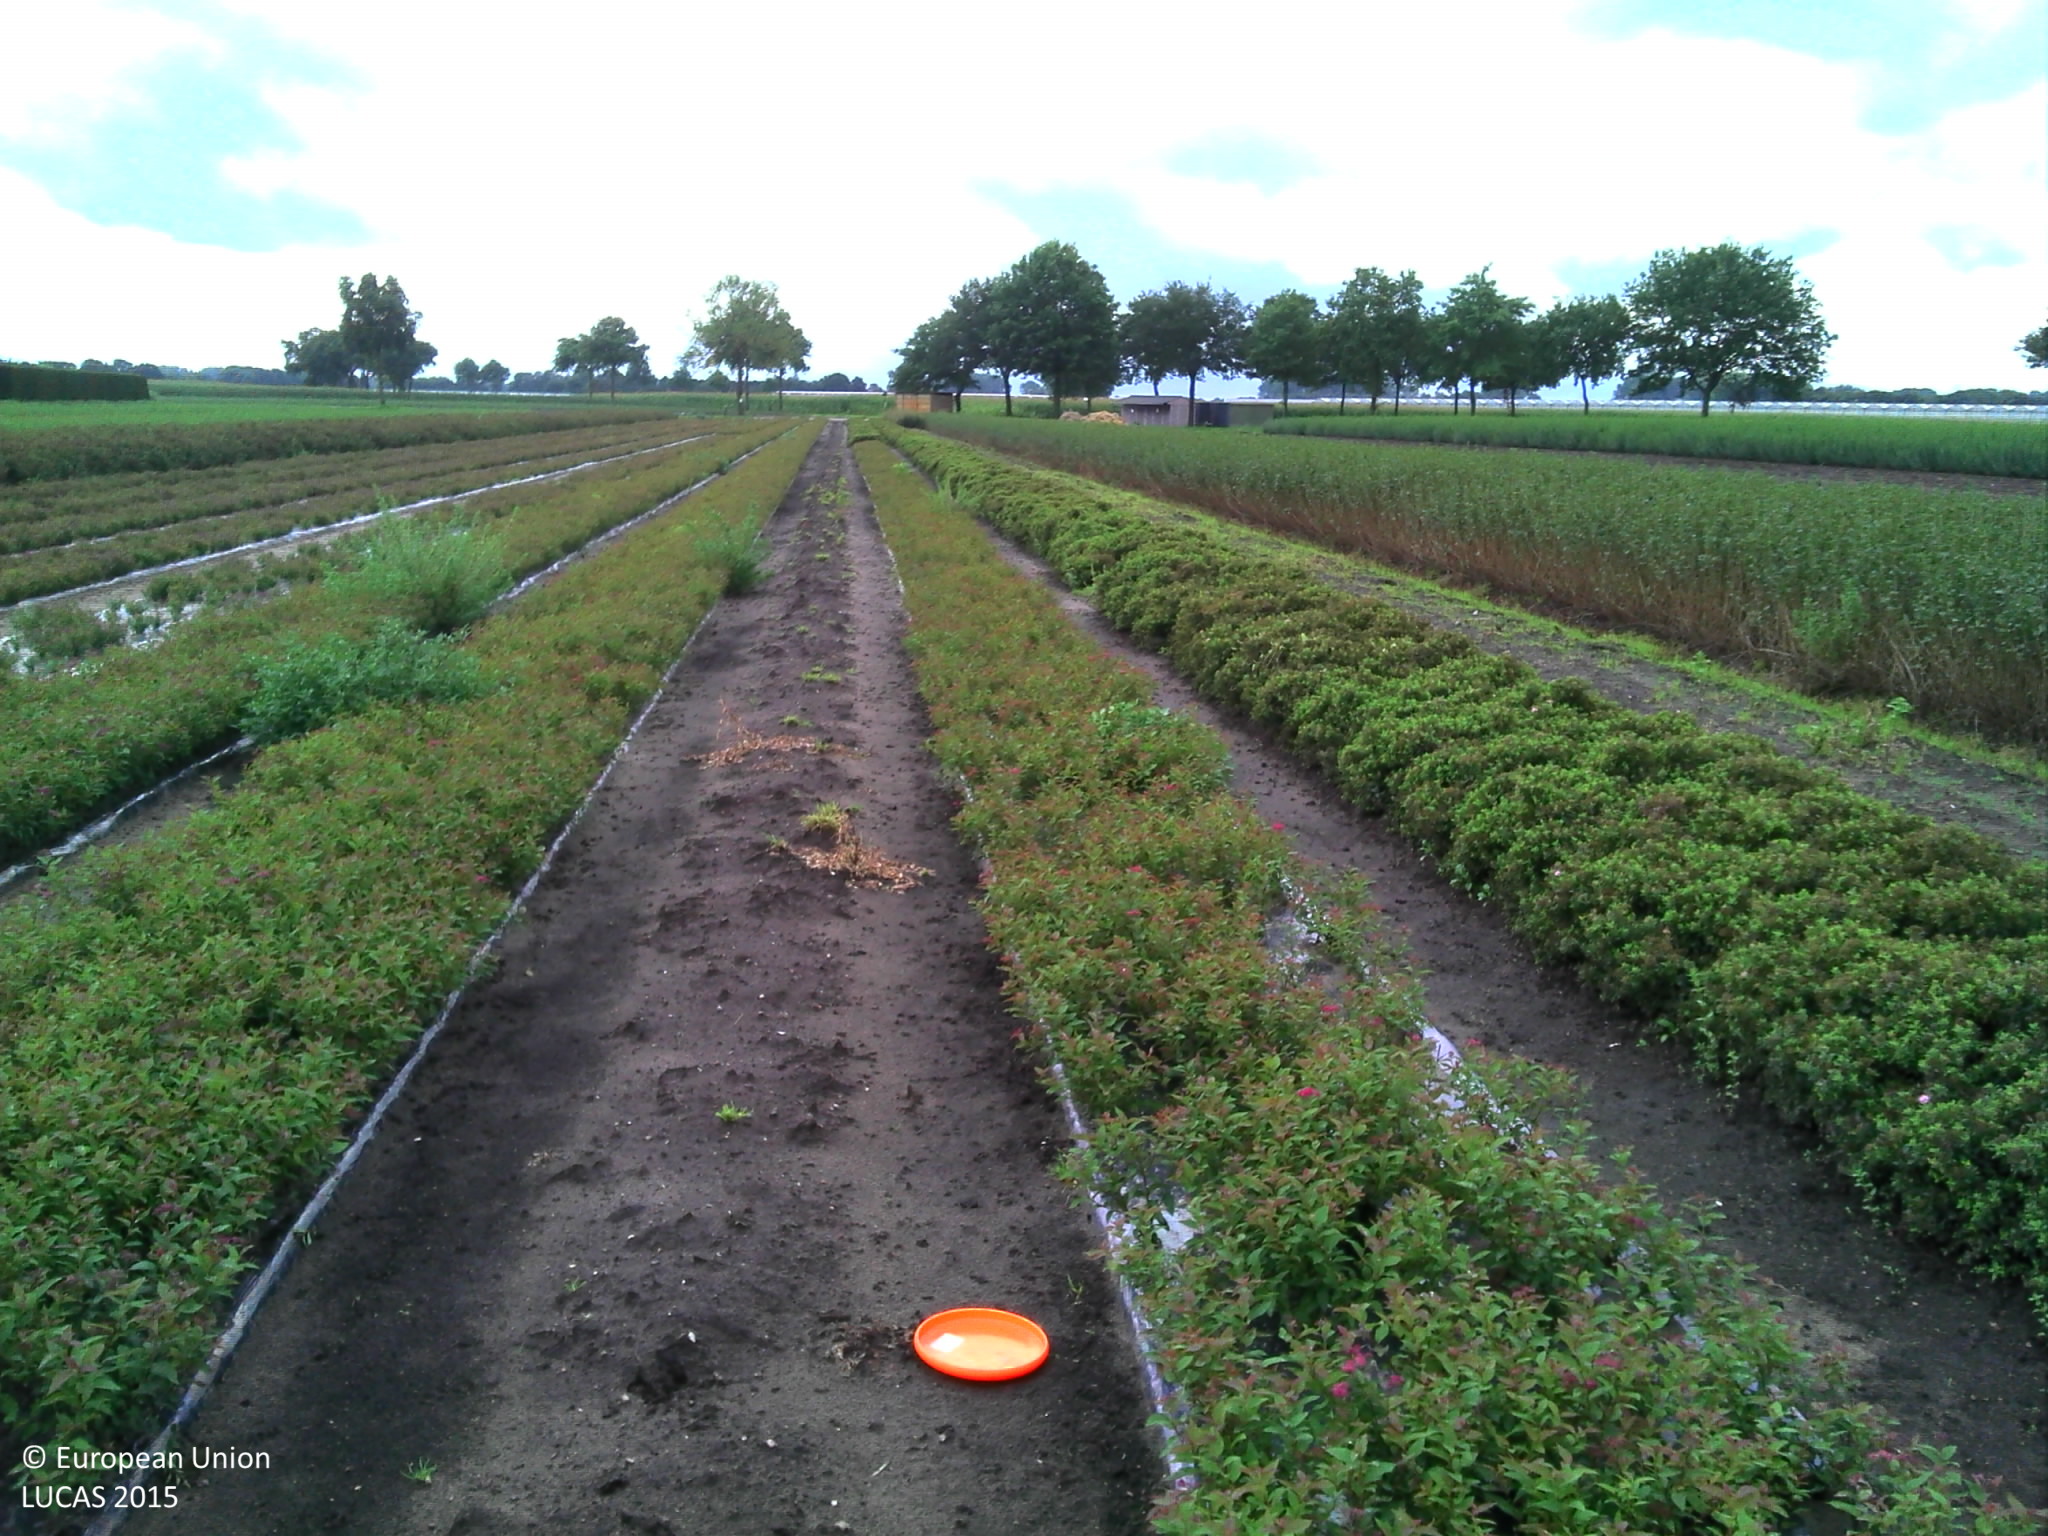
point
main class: Cropland
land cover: Nurseries
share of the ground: 50 - 75 %
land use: Agriculture (excluding fallow land and kitchen gardens)
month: September
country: BE
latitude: 51.4517
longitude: 4.7729
